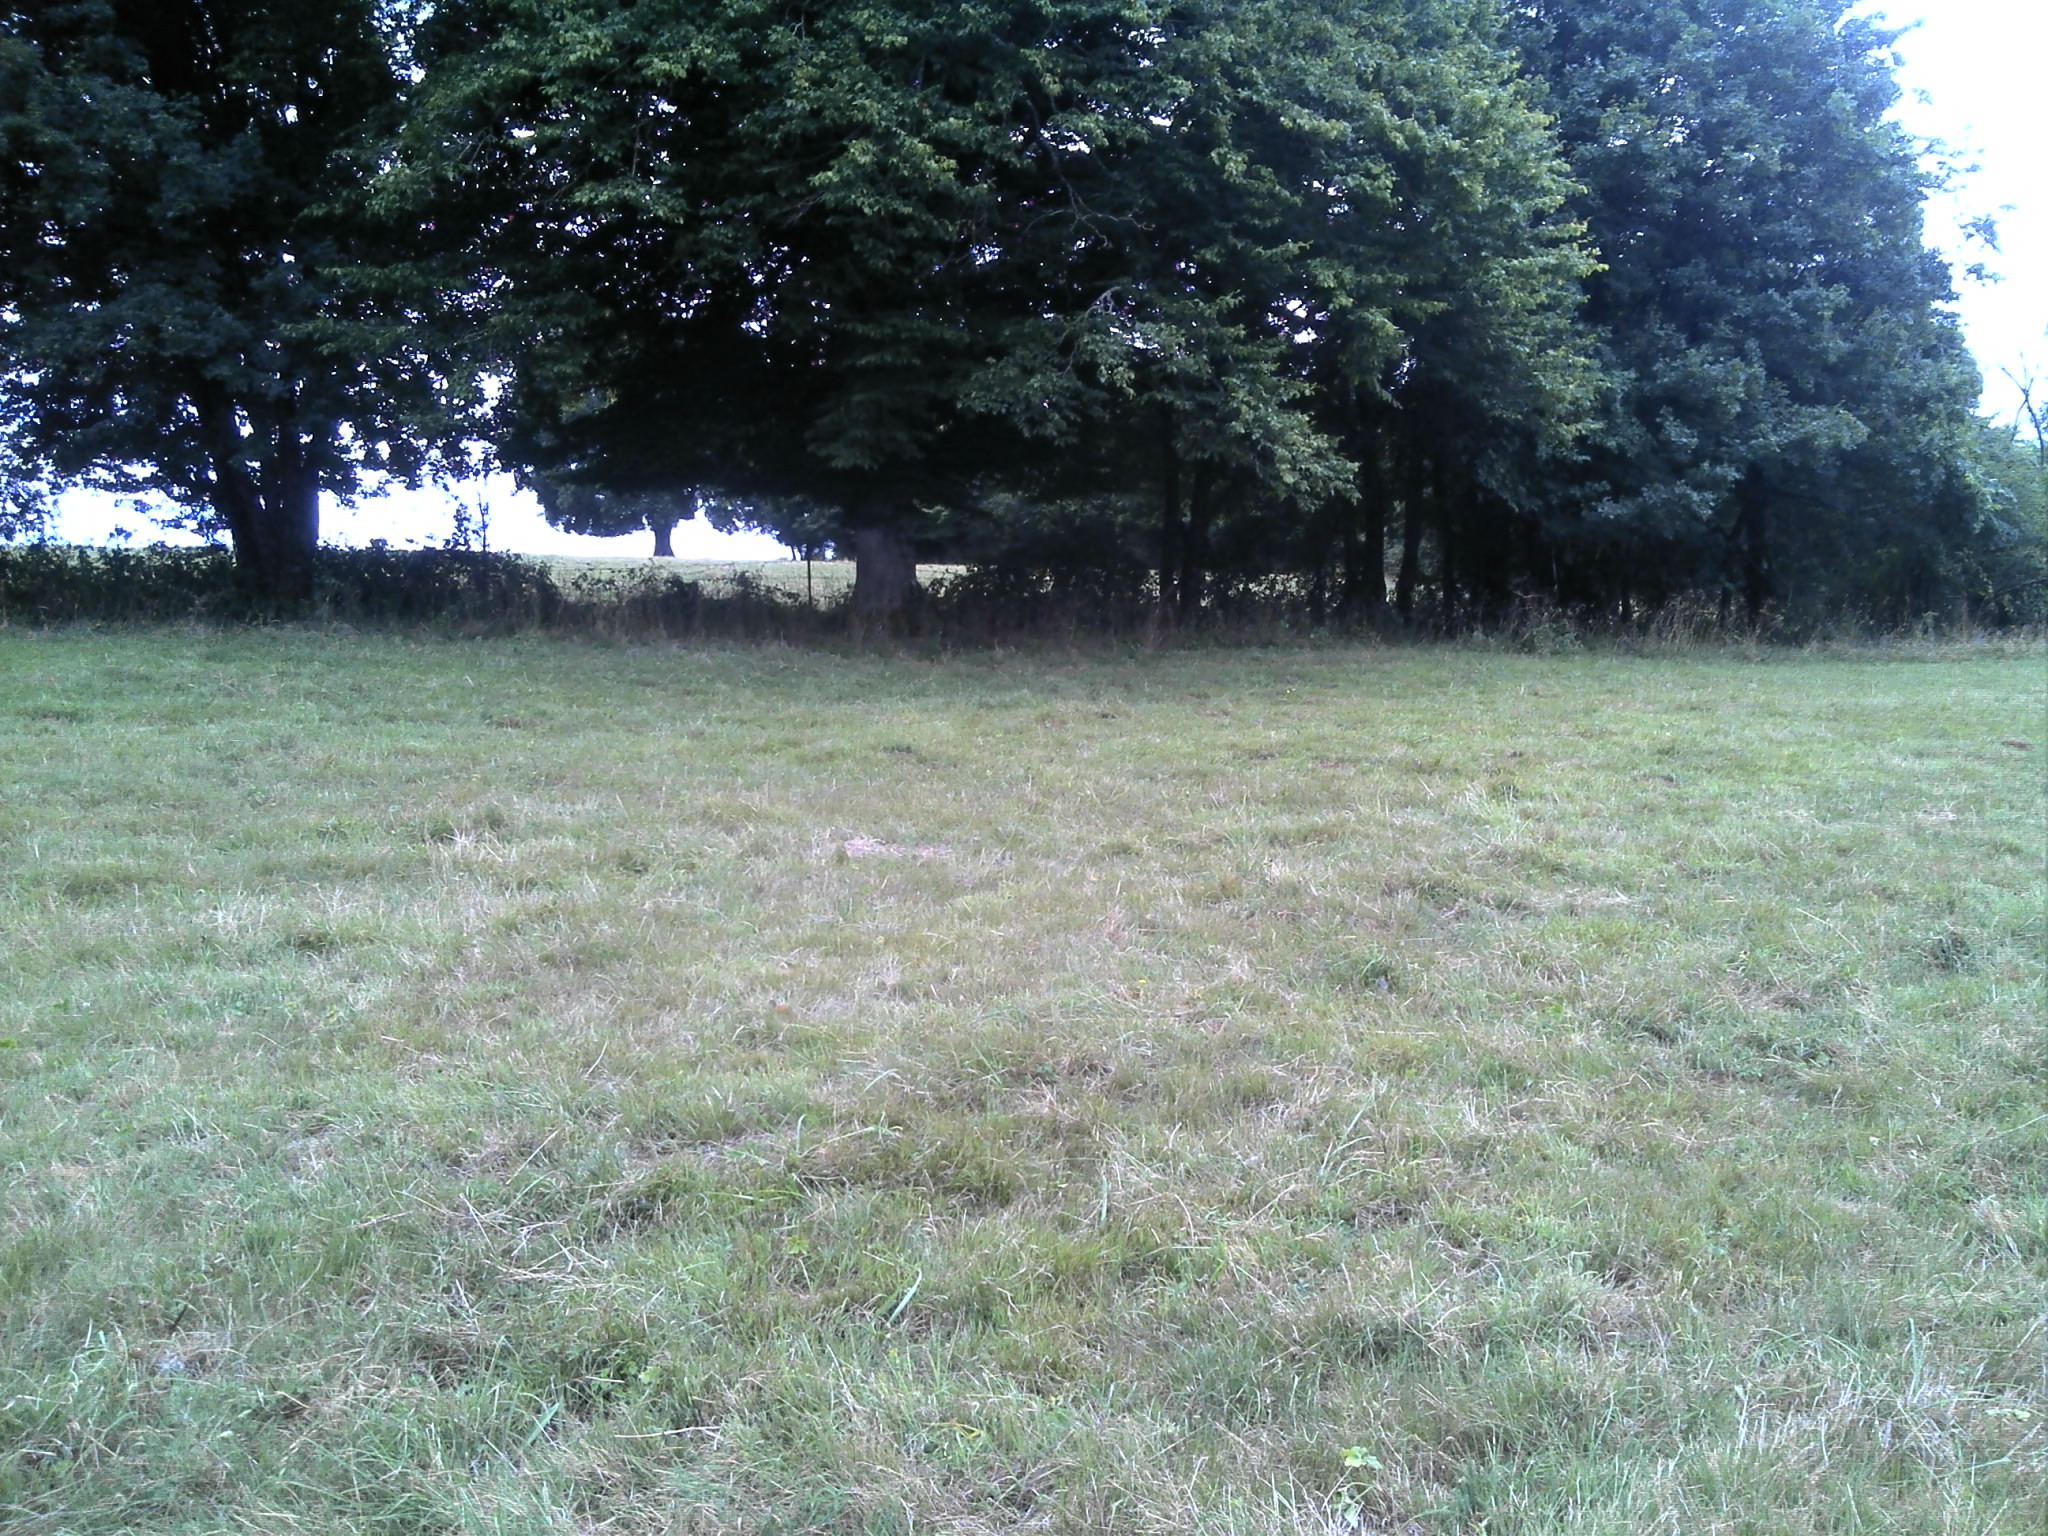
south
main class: Grassland
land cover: Grassland with sparse tree/shrub cover
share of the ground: > 75 %
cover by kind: herbaceous plants 95 %, broadleaved forest trees 5 %
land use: Agriculture (excluding fallow land and kitchen gardens)
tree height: > 5 m
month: July
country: FR
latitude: 46.5217
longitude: 1.5298
